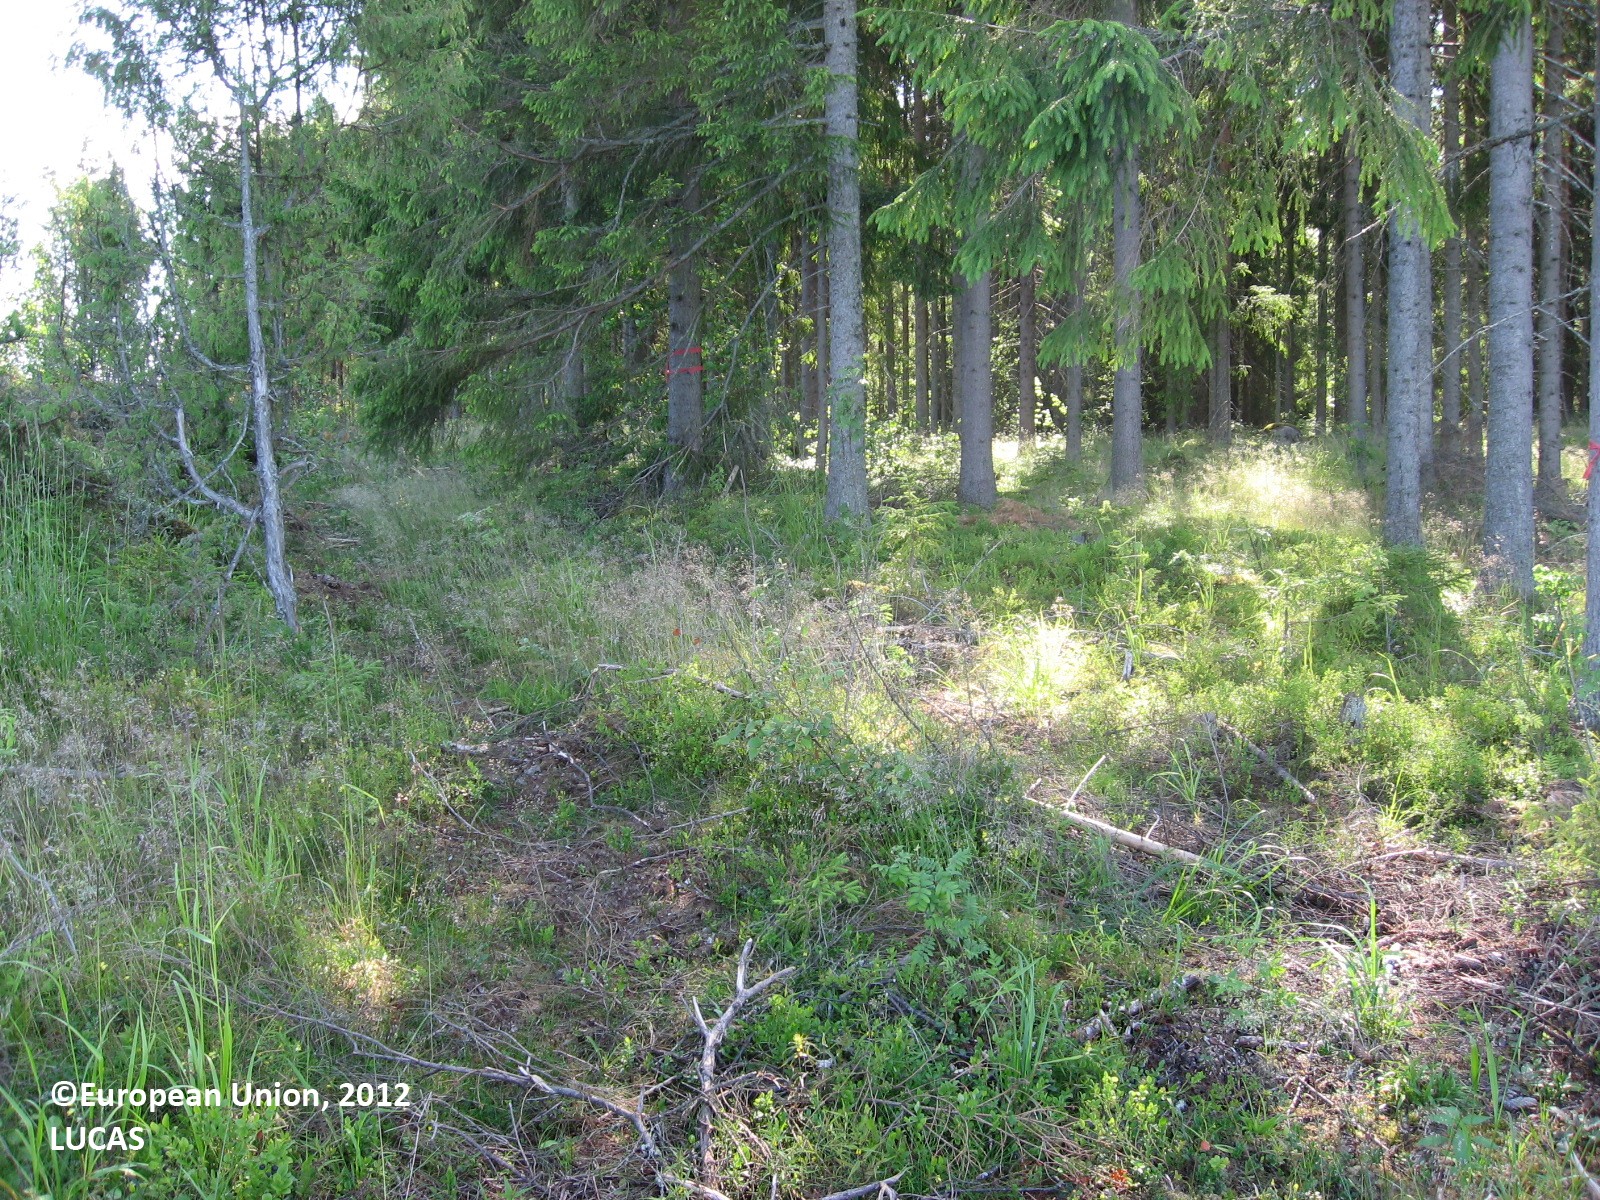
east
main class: Grassland
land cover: Grassland with sparse tree/shrub cover
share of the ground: 50 - 75 %
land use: Forestry
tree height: < 5 m
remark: Clear cut
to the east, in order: Grassland with sparse tree/shrub cover; Spruce dominated coniferous woodland; Ditches and canals; Spruce dominated coniferous woodland; Pine dominated mixed woodland
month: July
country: FI
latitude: 60.8129
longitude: 26.2688
